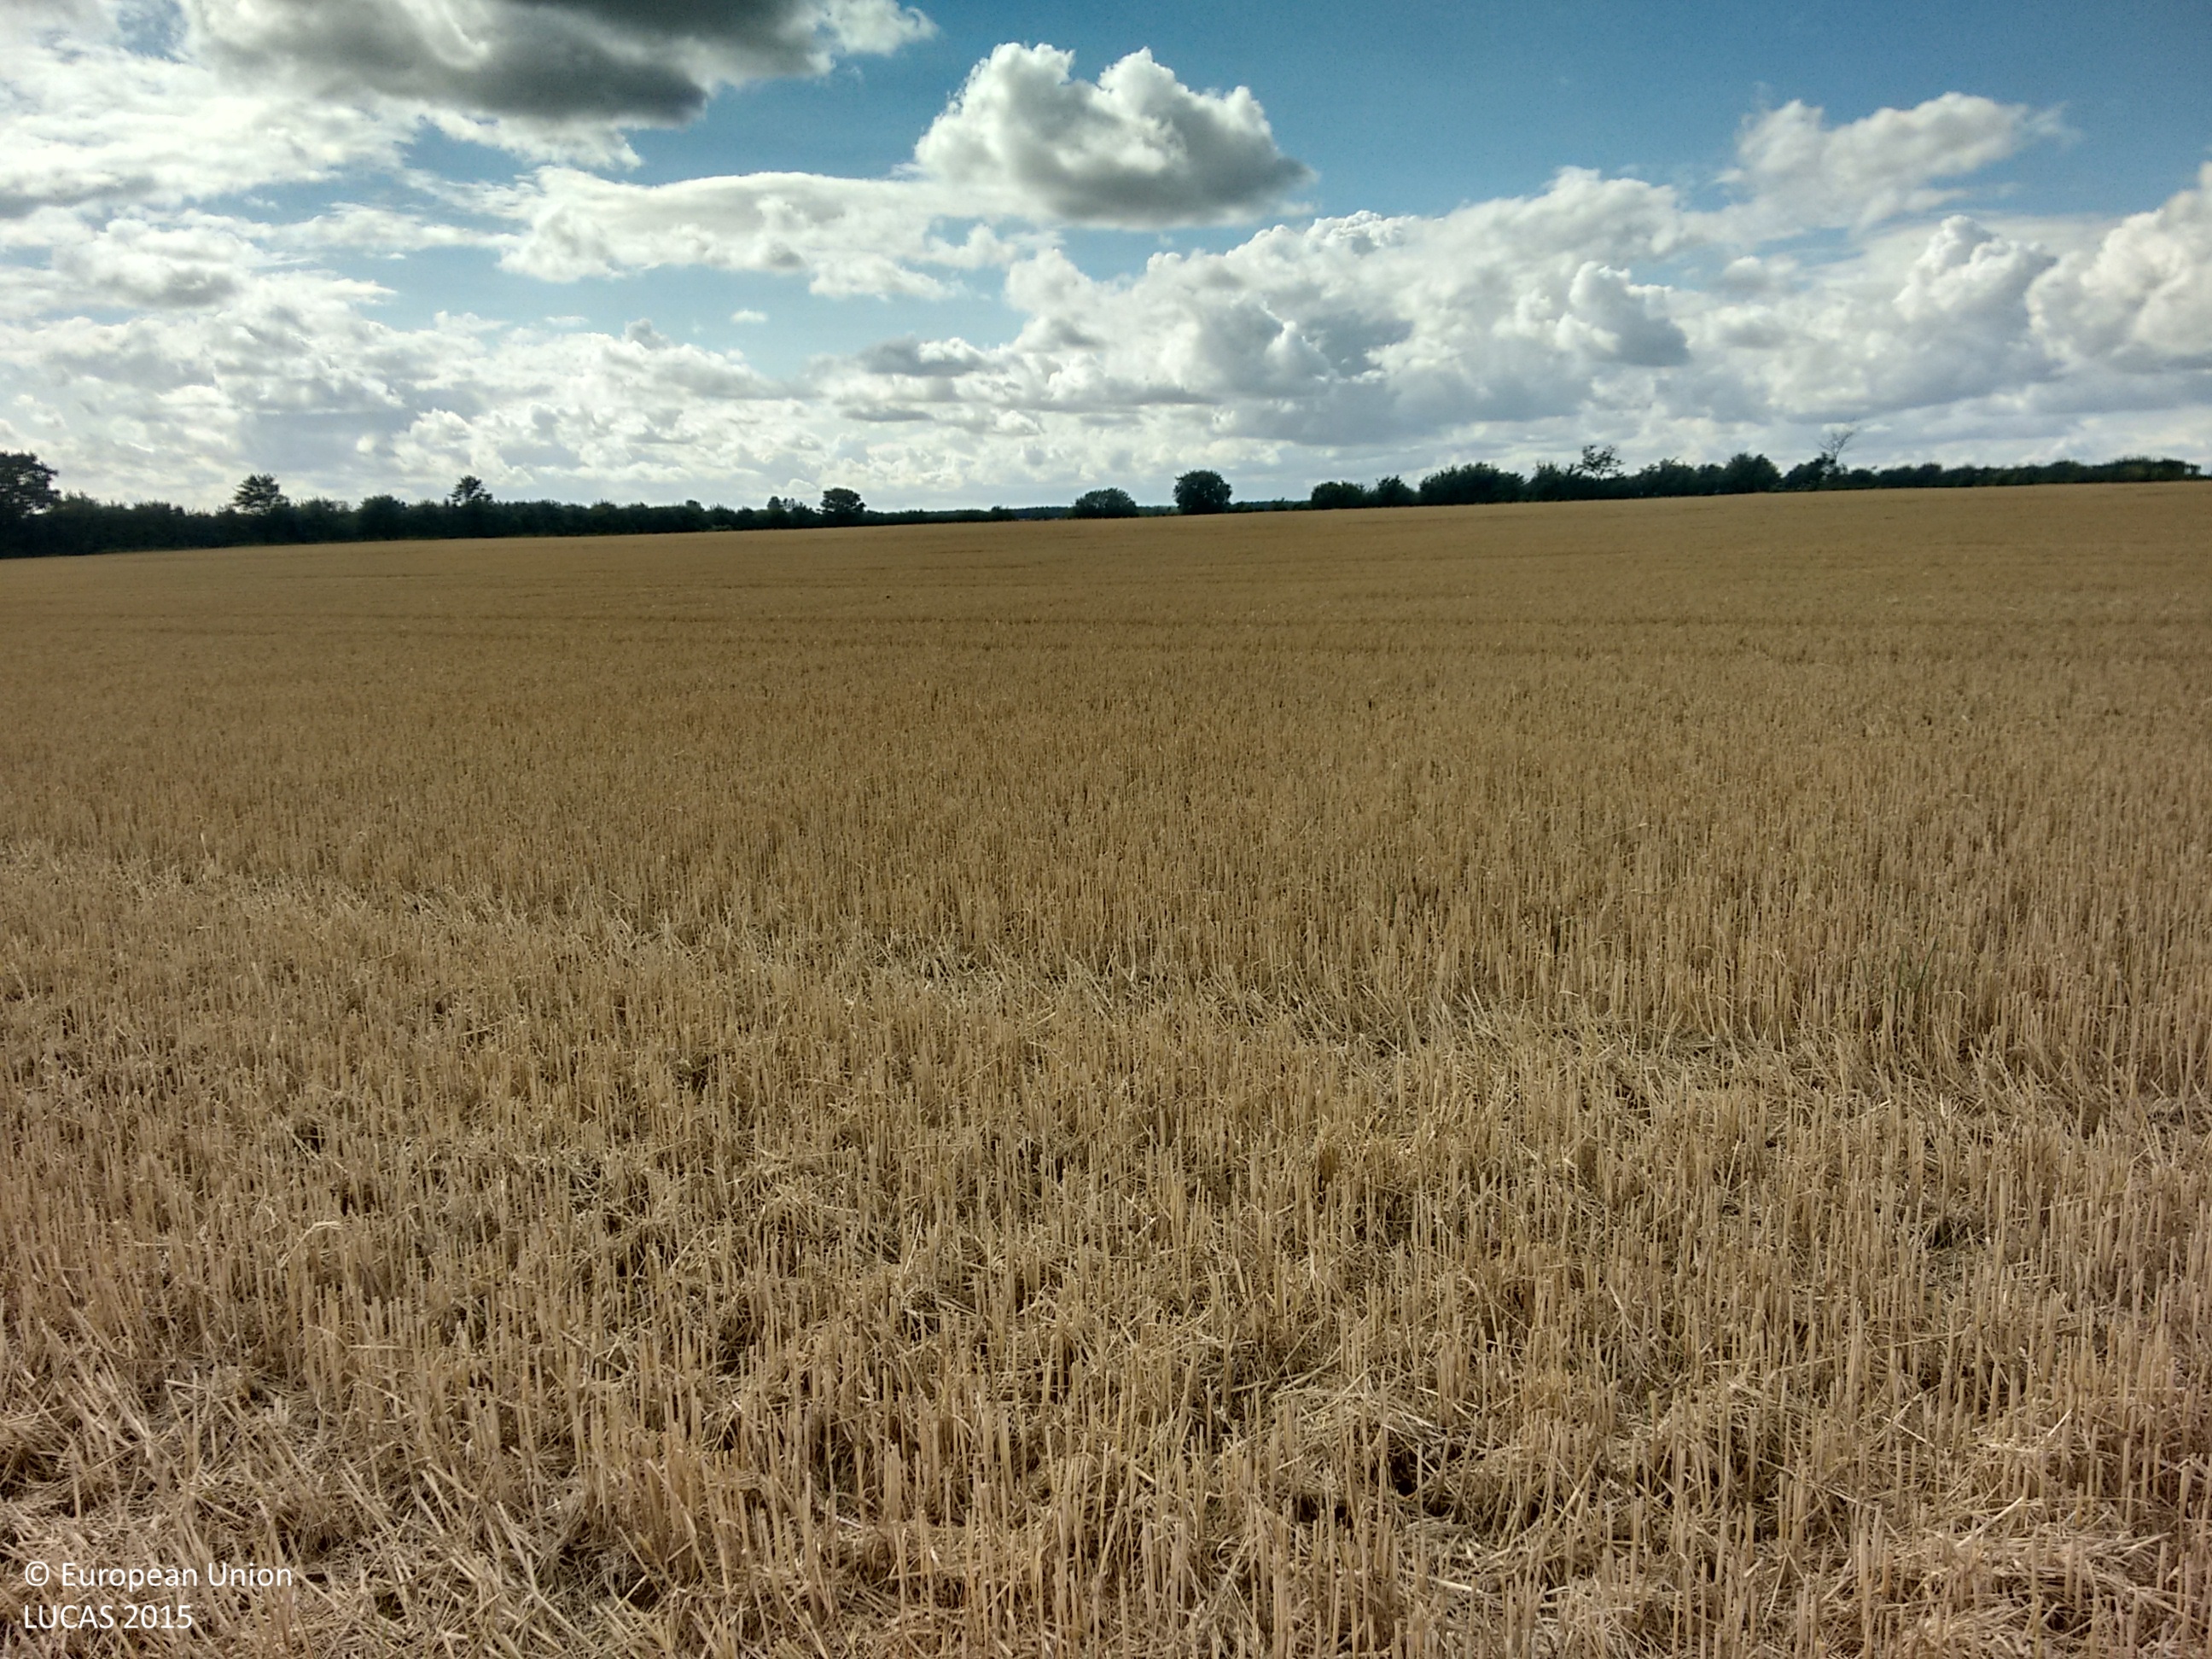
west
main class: Cropland
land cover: Common wheat
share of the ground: > 75 %
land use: Agriculture (excluding fallow land and kitchen gardens)
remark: Harvested field
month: August
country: GB
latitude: 52.1645
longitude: 0.5726
